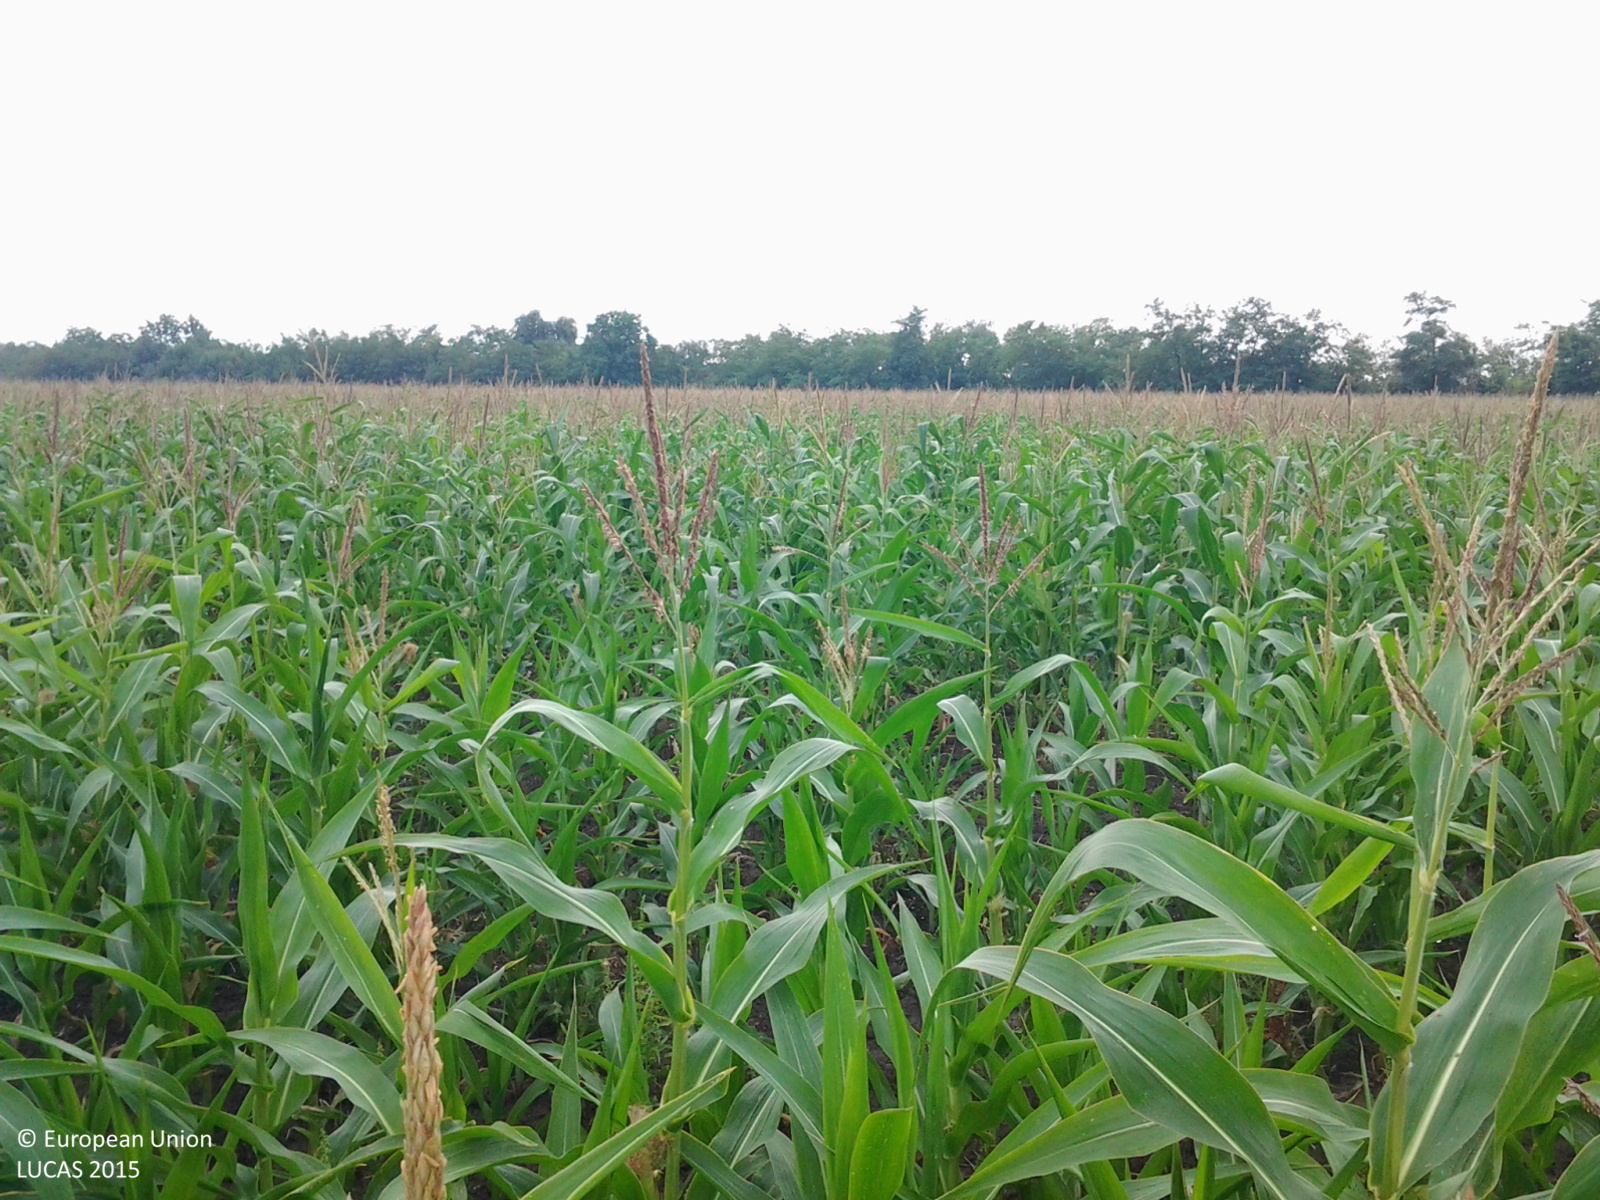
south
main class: Cropland
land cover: Maize
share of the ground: > 75 %
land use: Agriculture (excluding fallow land and kitchen gardens)
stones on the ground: < 10 %
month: August
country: HU
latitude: 47.2304
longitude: 20.5038
